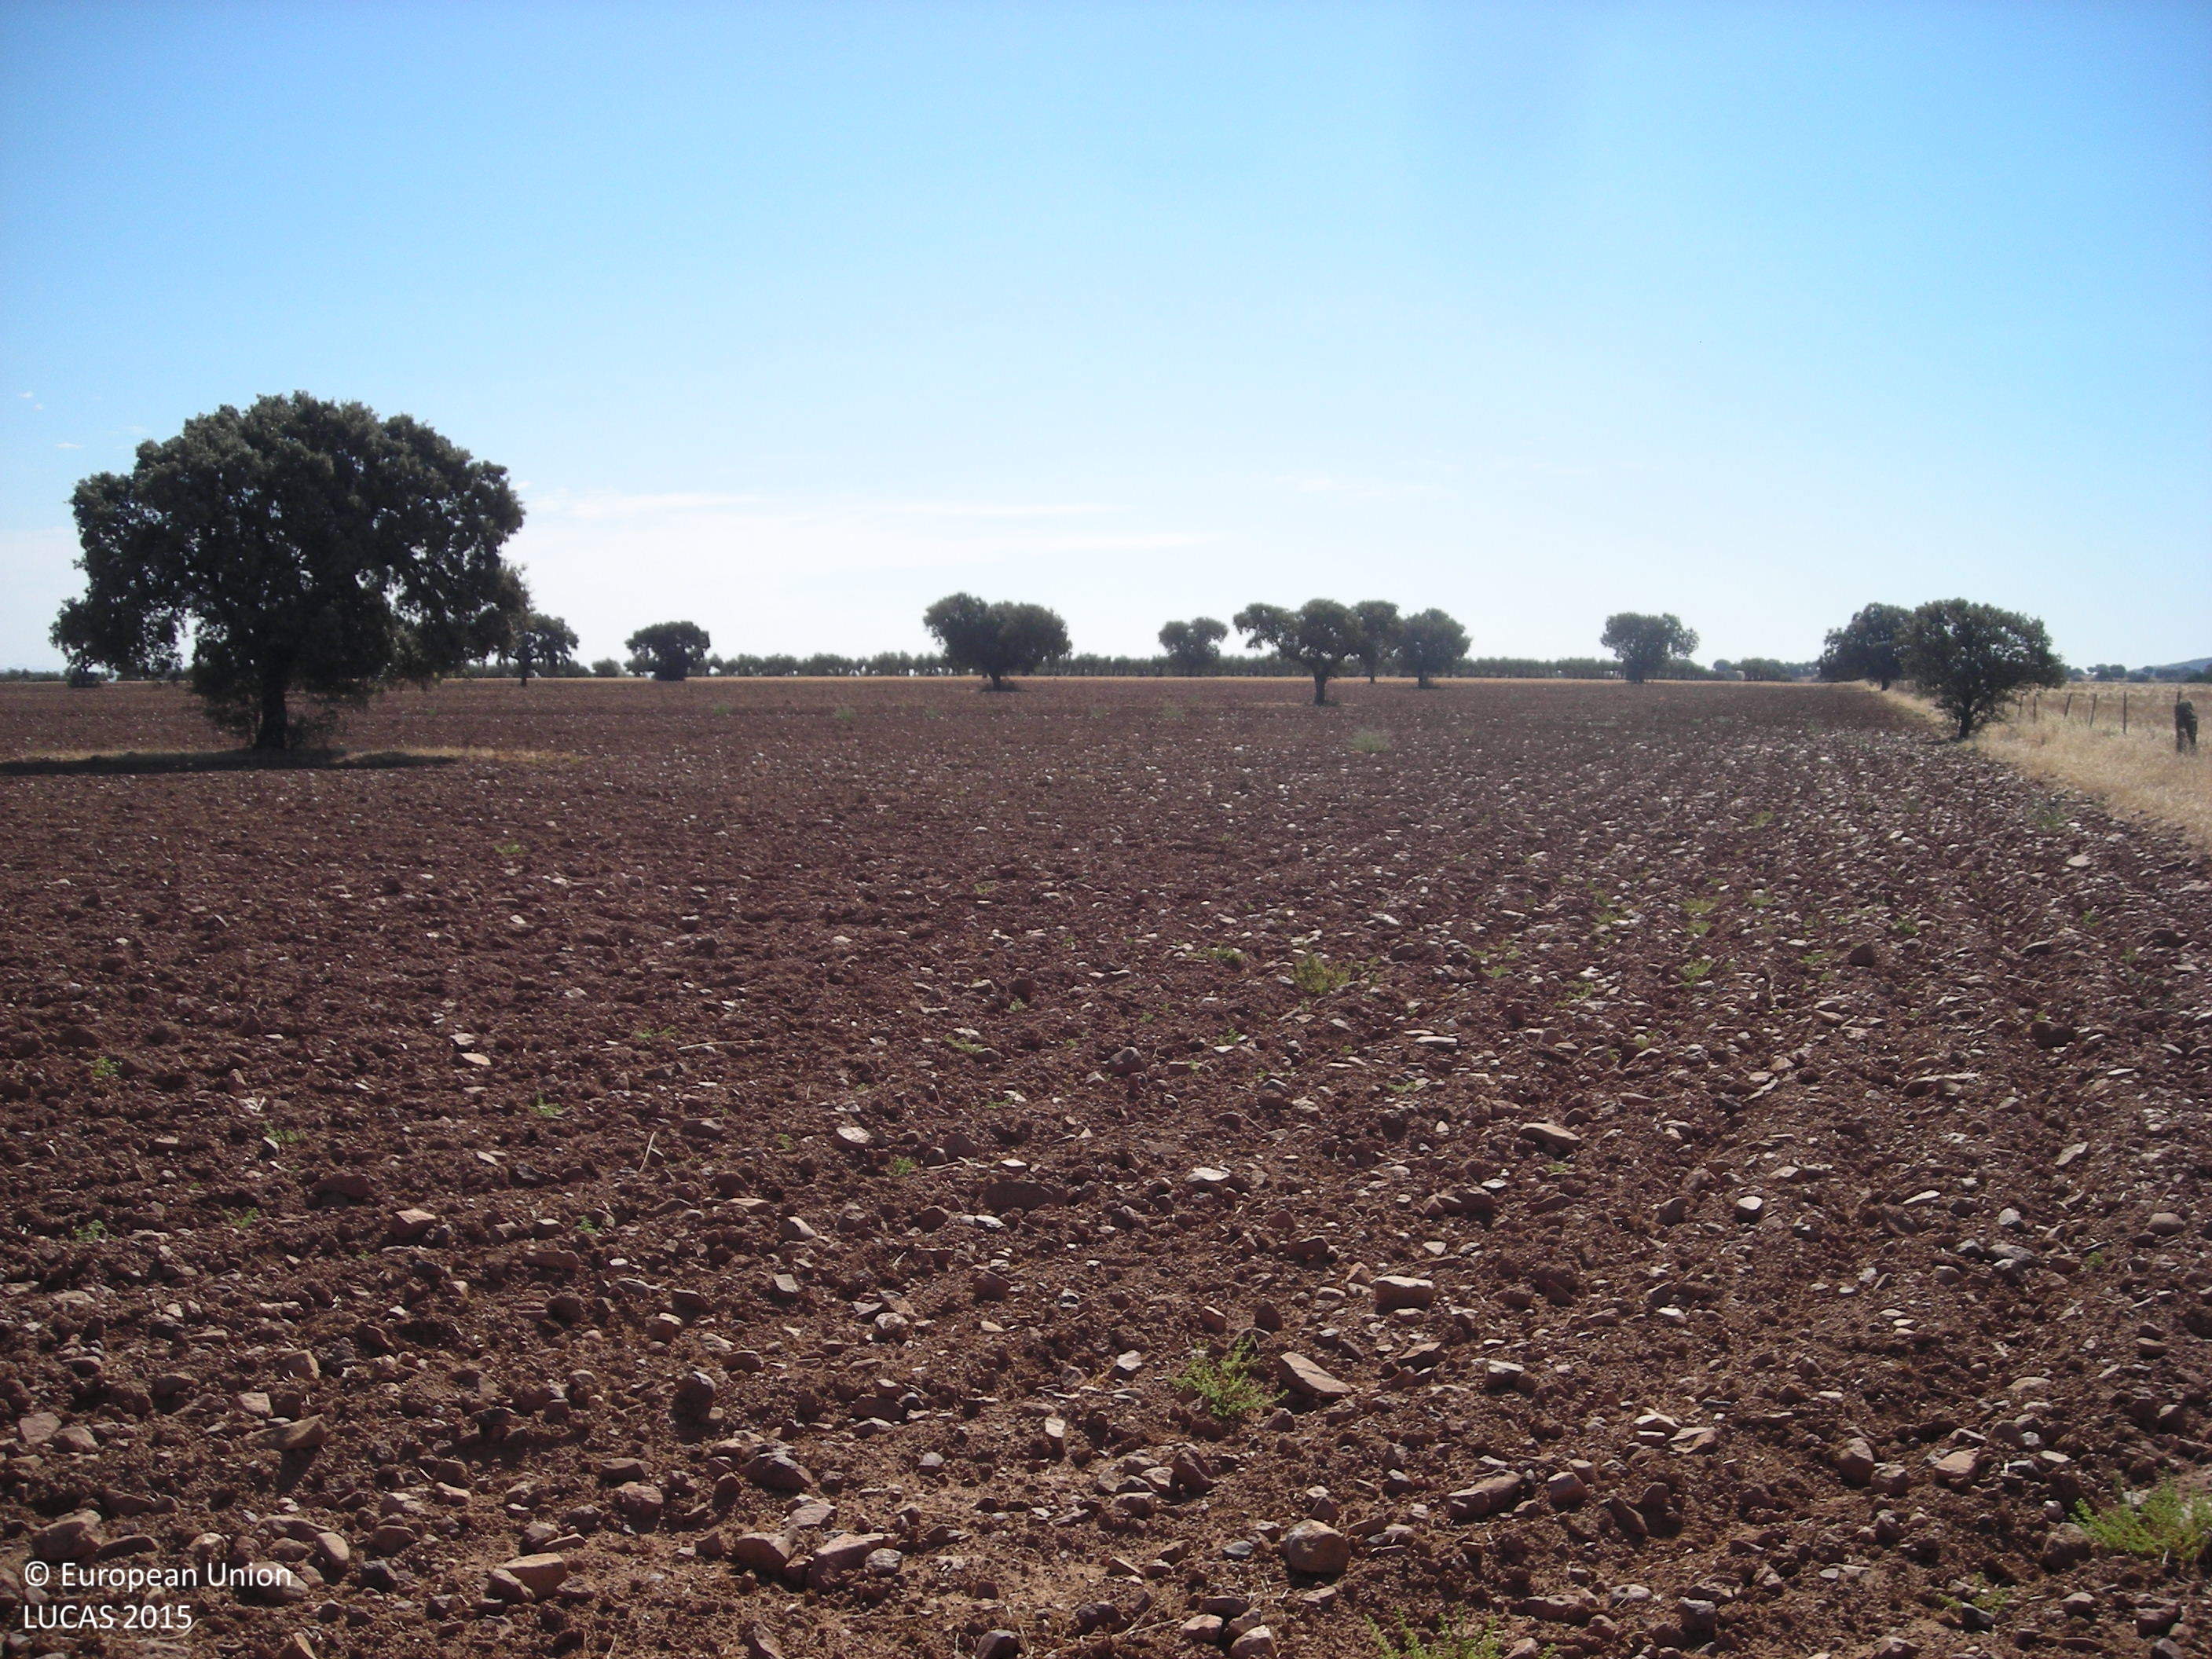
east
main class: Cropland
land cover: Olive groves
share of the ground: 10 - 25 %
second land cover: Other bare soil
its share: > 75 %
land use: Agriculture (excluding fallow land and kitchen gardens)
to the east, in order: Olive groves; Other bare soil; Lines of trees
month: July
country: ES
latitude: 38.8244
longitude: -5.8382
